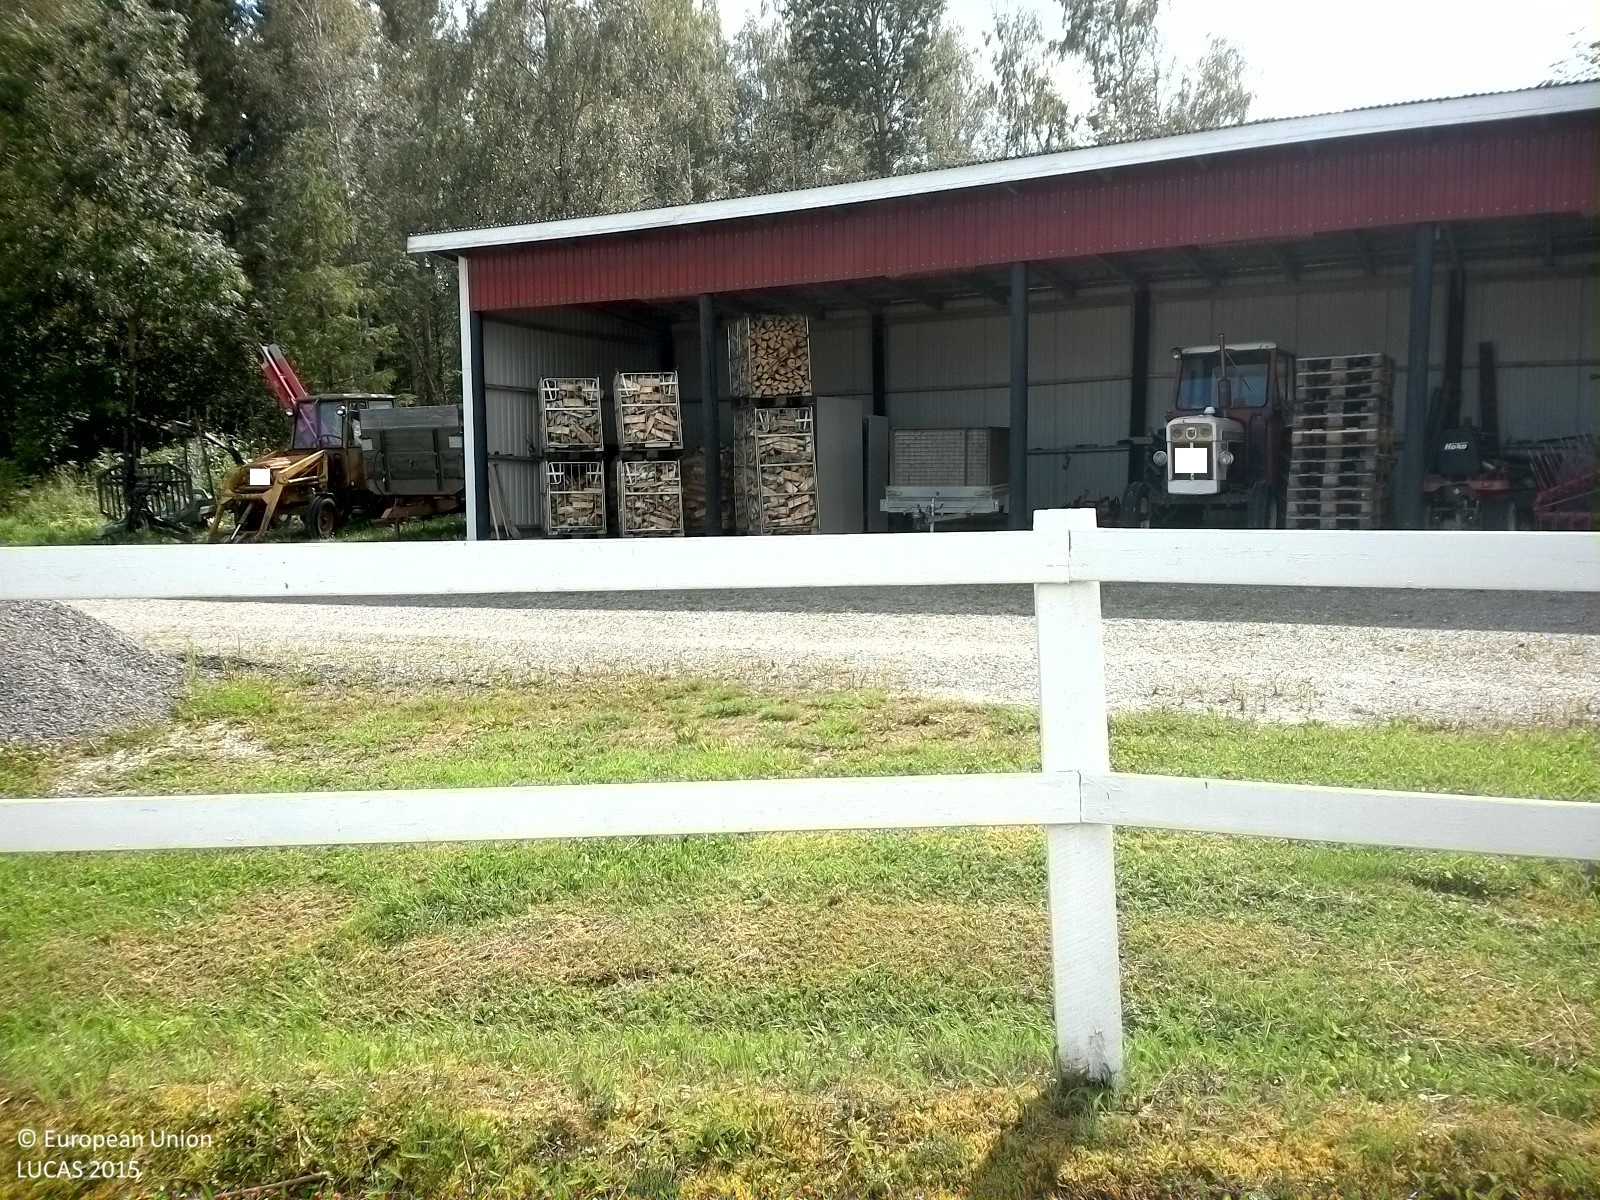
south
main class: Grassland
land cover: Grassland without tree/shrub cover
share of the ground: > 75 %
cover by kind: herbaceous plants 90 %, consolidated bare surface 10 %
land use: Sport
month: August
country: SE
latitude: 59.2064
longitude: 15.0528
